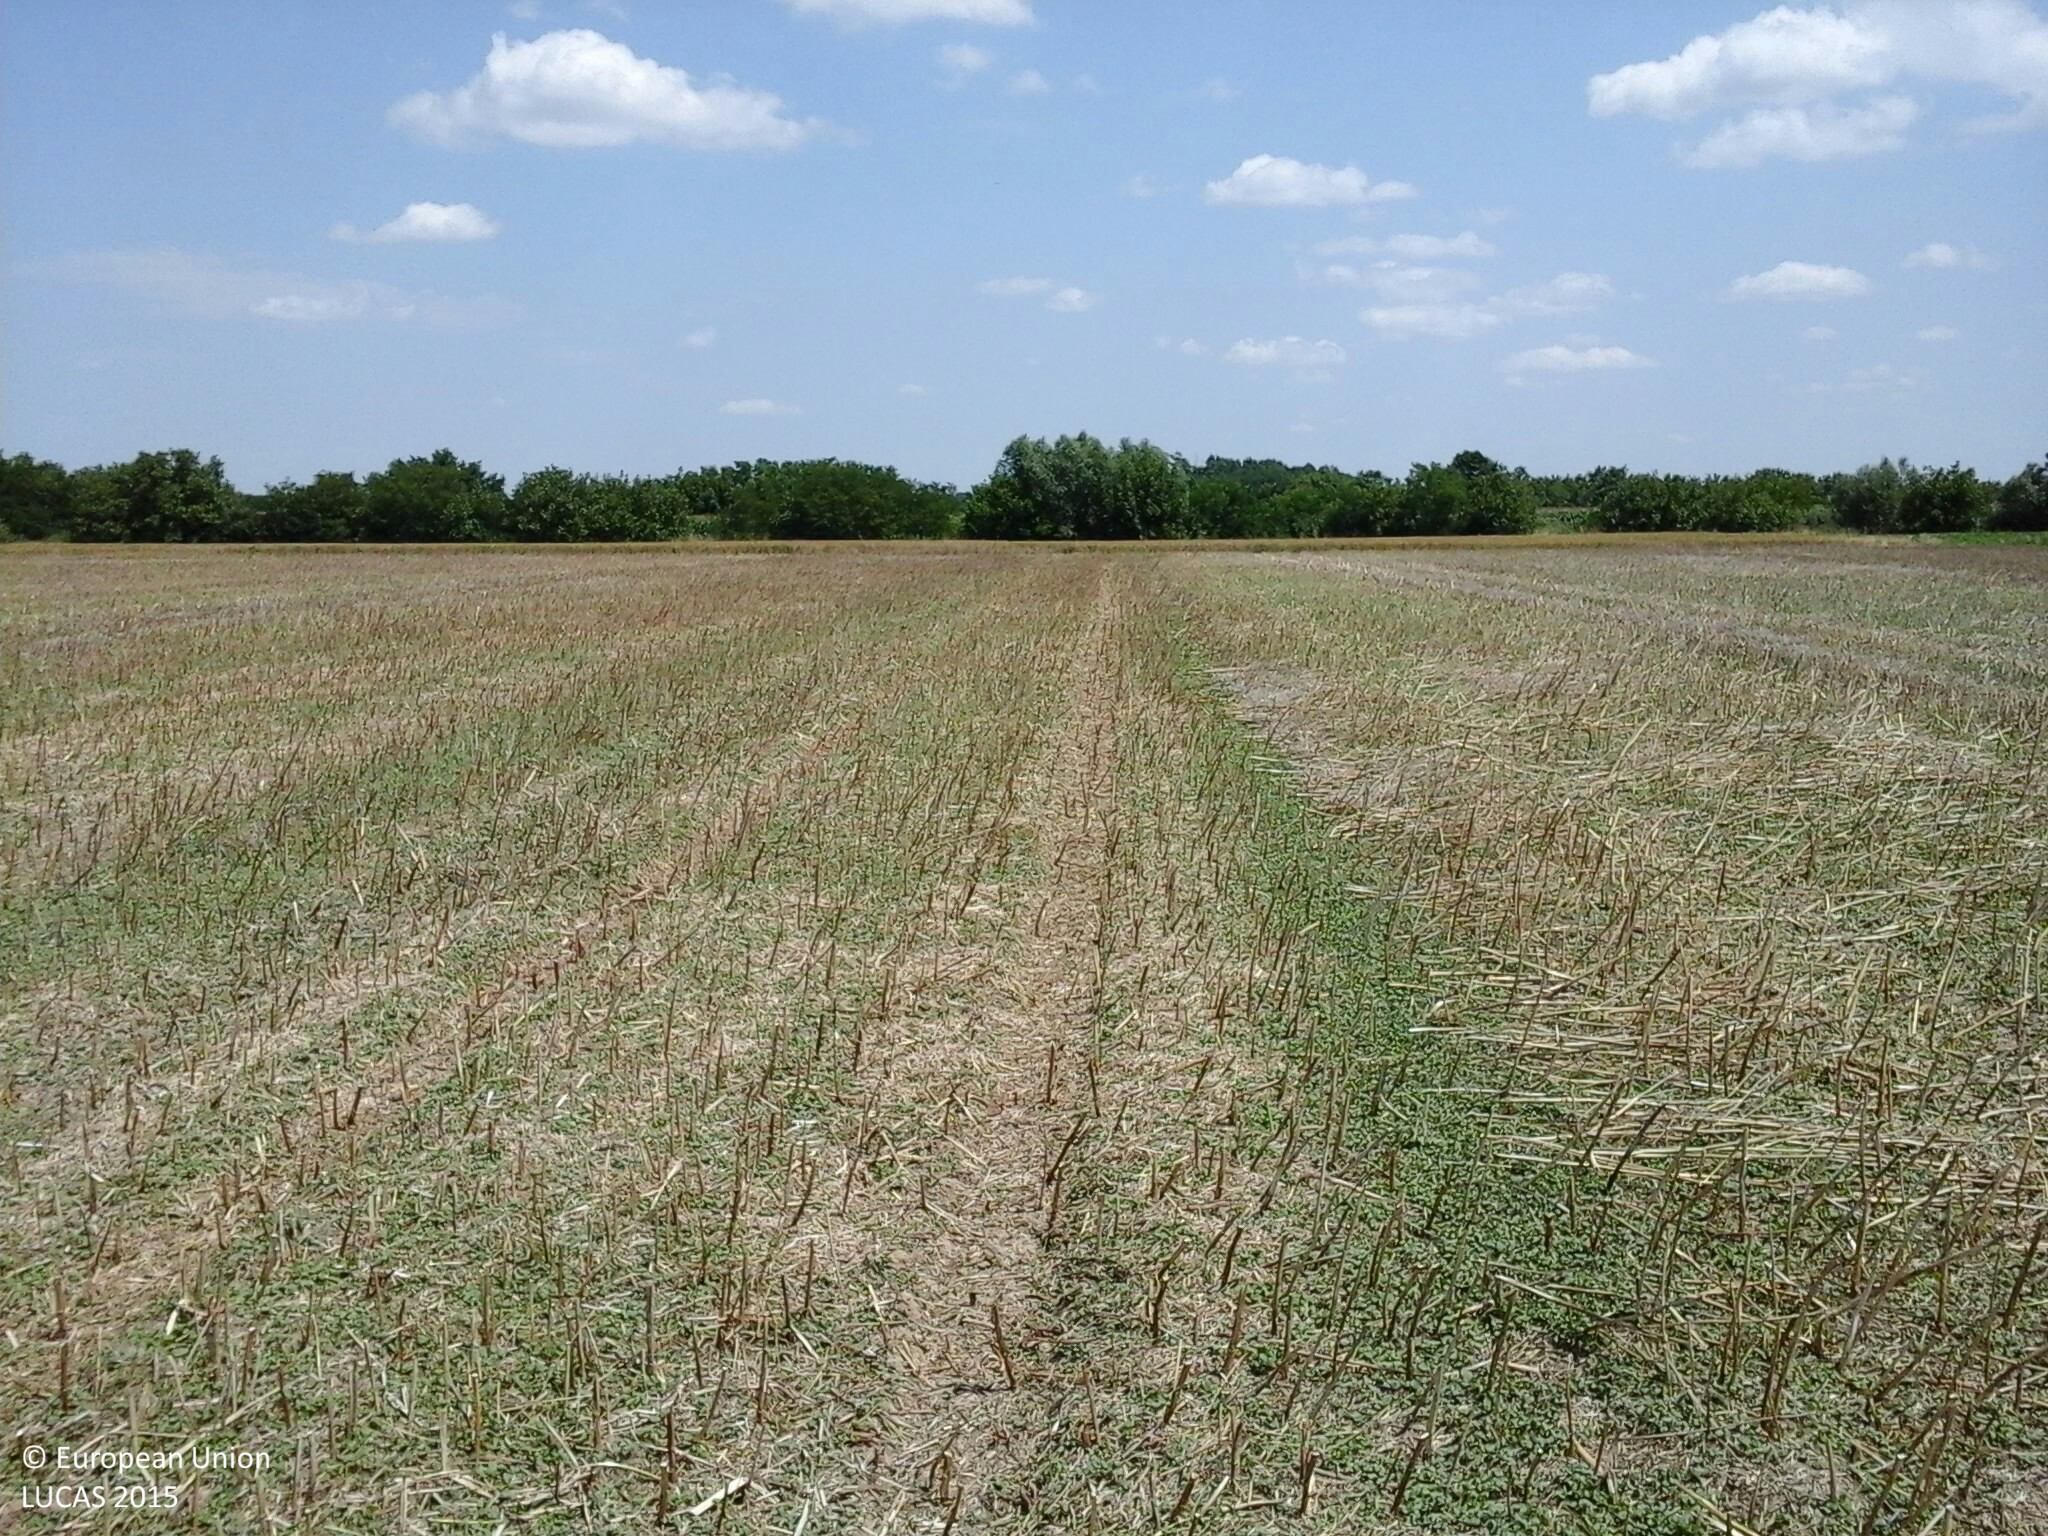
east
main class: Cropland
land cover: Rape and turnip rape
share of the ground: < 10 %
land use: Agriculture (excluding fallow land and kitchen gardens)
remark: Harvested field
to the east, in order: Rape and turnip rape; Barley; Grassland with sparse tree/shrub cover; Ditches and canals; Grassland with sparse tree/shrub cover; Grass margins; Paved roads, cycling and walking lanes; Grass margins; Ditches and canals; Maize
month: July
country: HU
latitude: 47.0817
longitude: 16.6811
